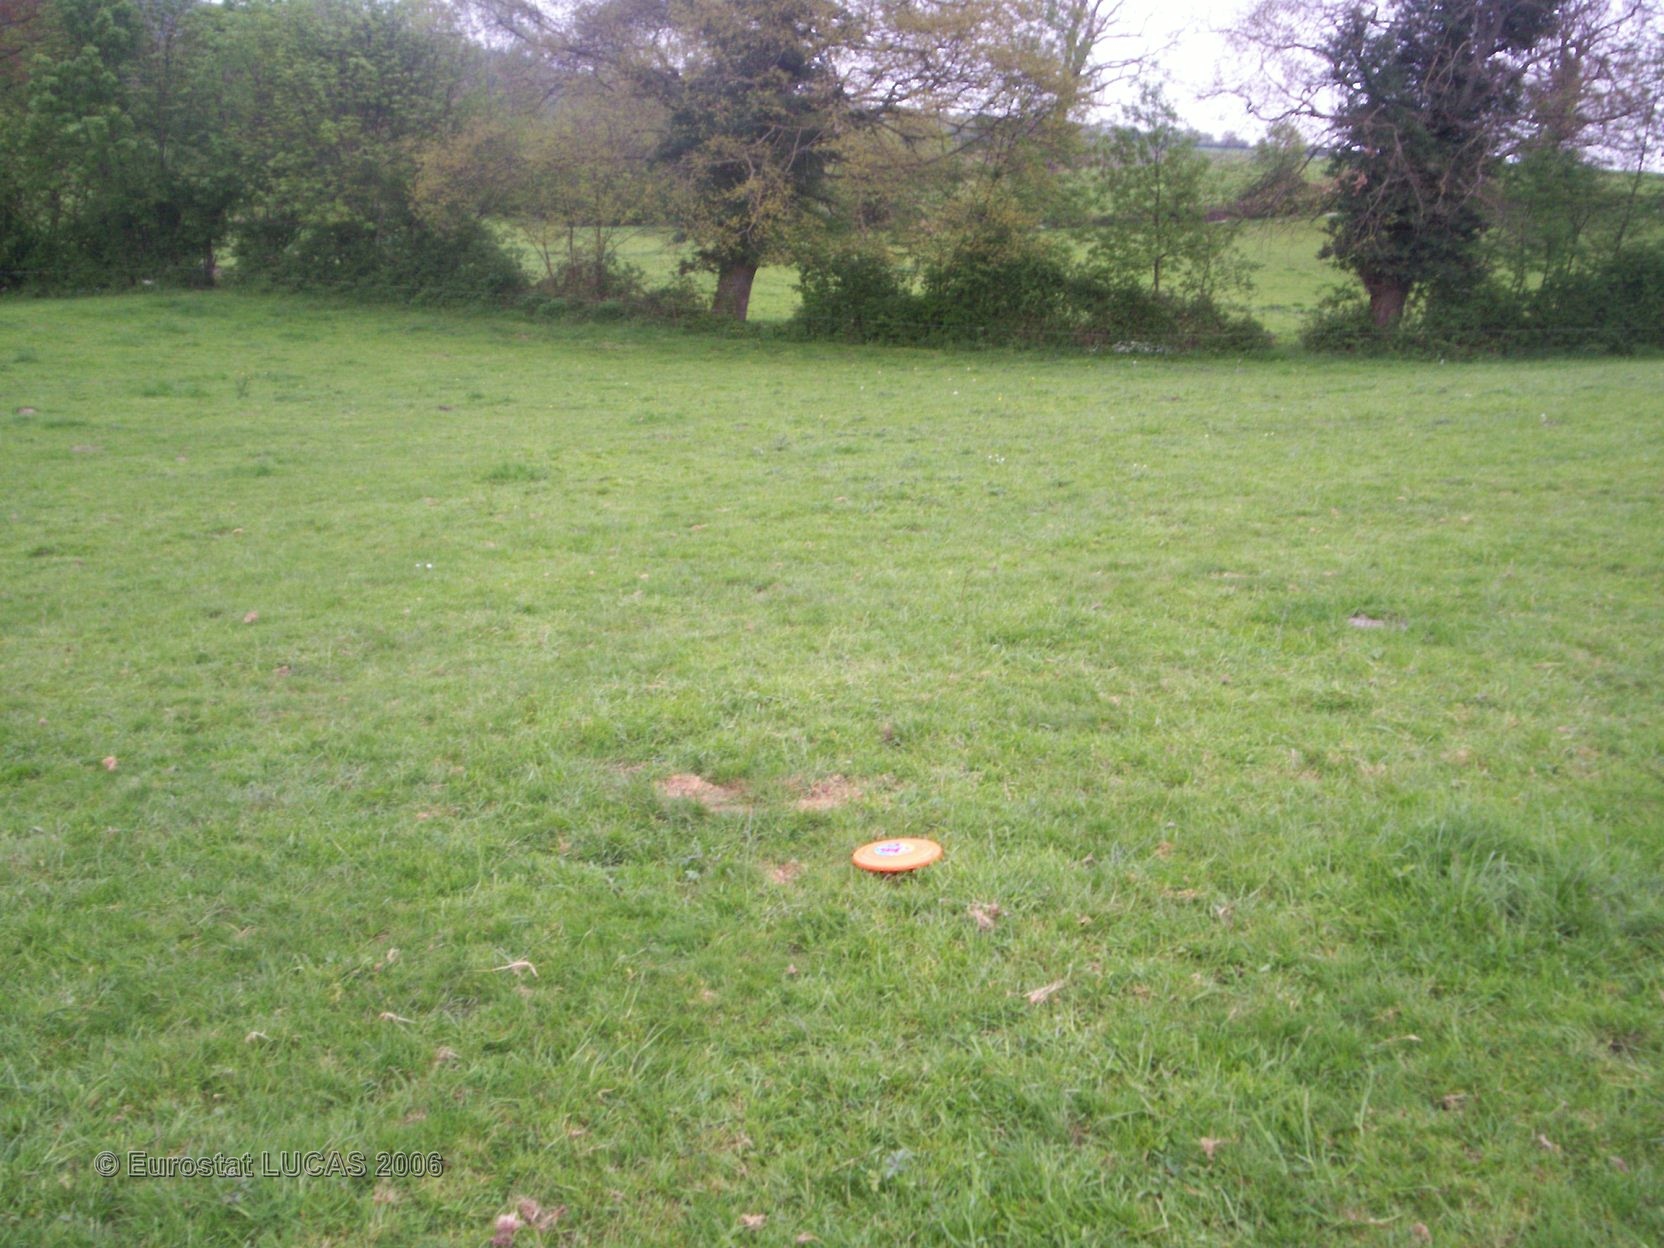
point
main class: Grassland
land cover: Grassland without tree/shrub cover
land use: Agriculture (excluding fallow land and kitchen gardens)
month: May
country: FR
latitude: 46.4901
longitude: 3.1058
